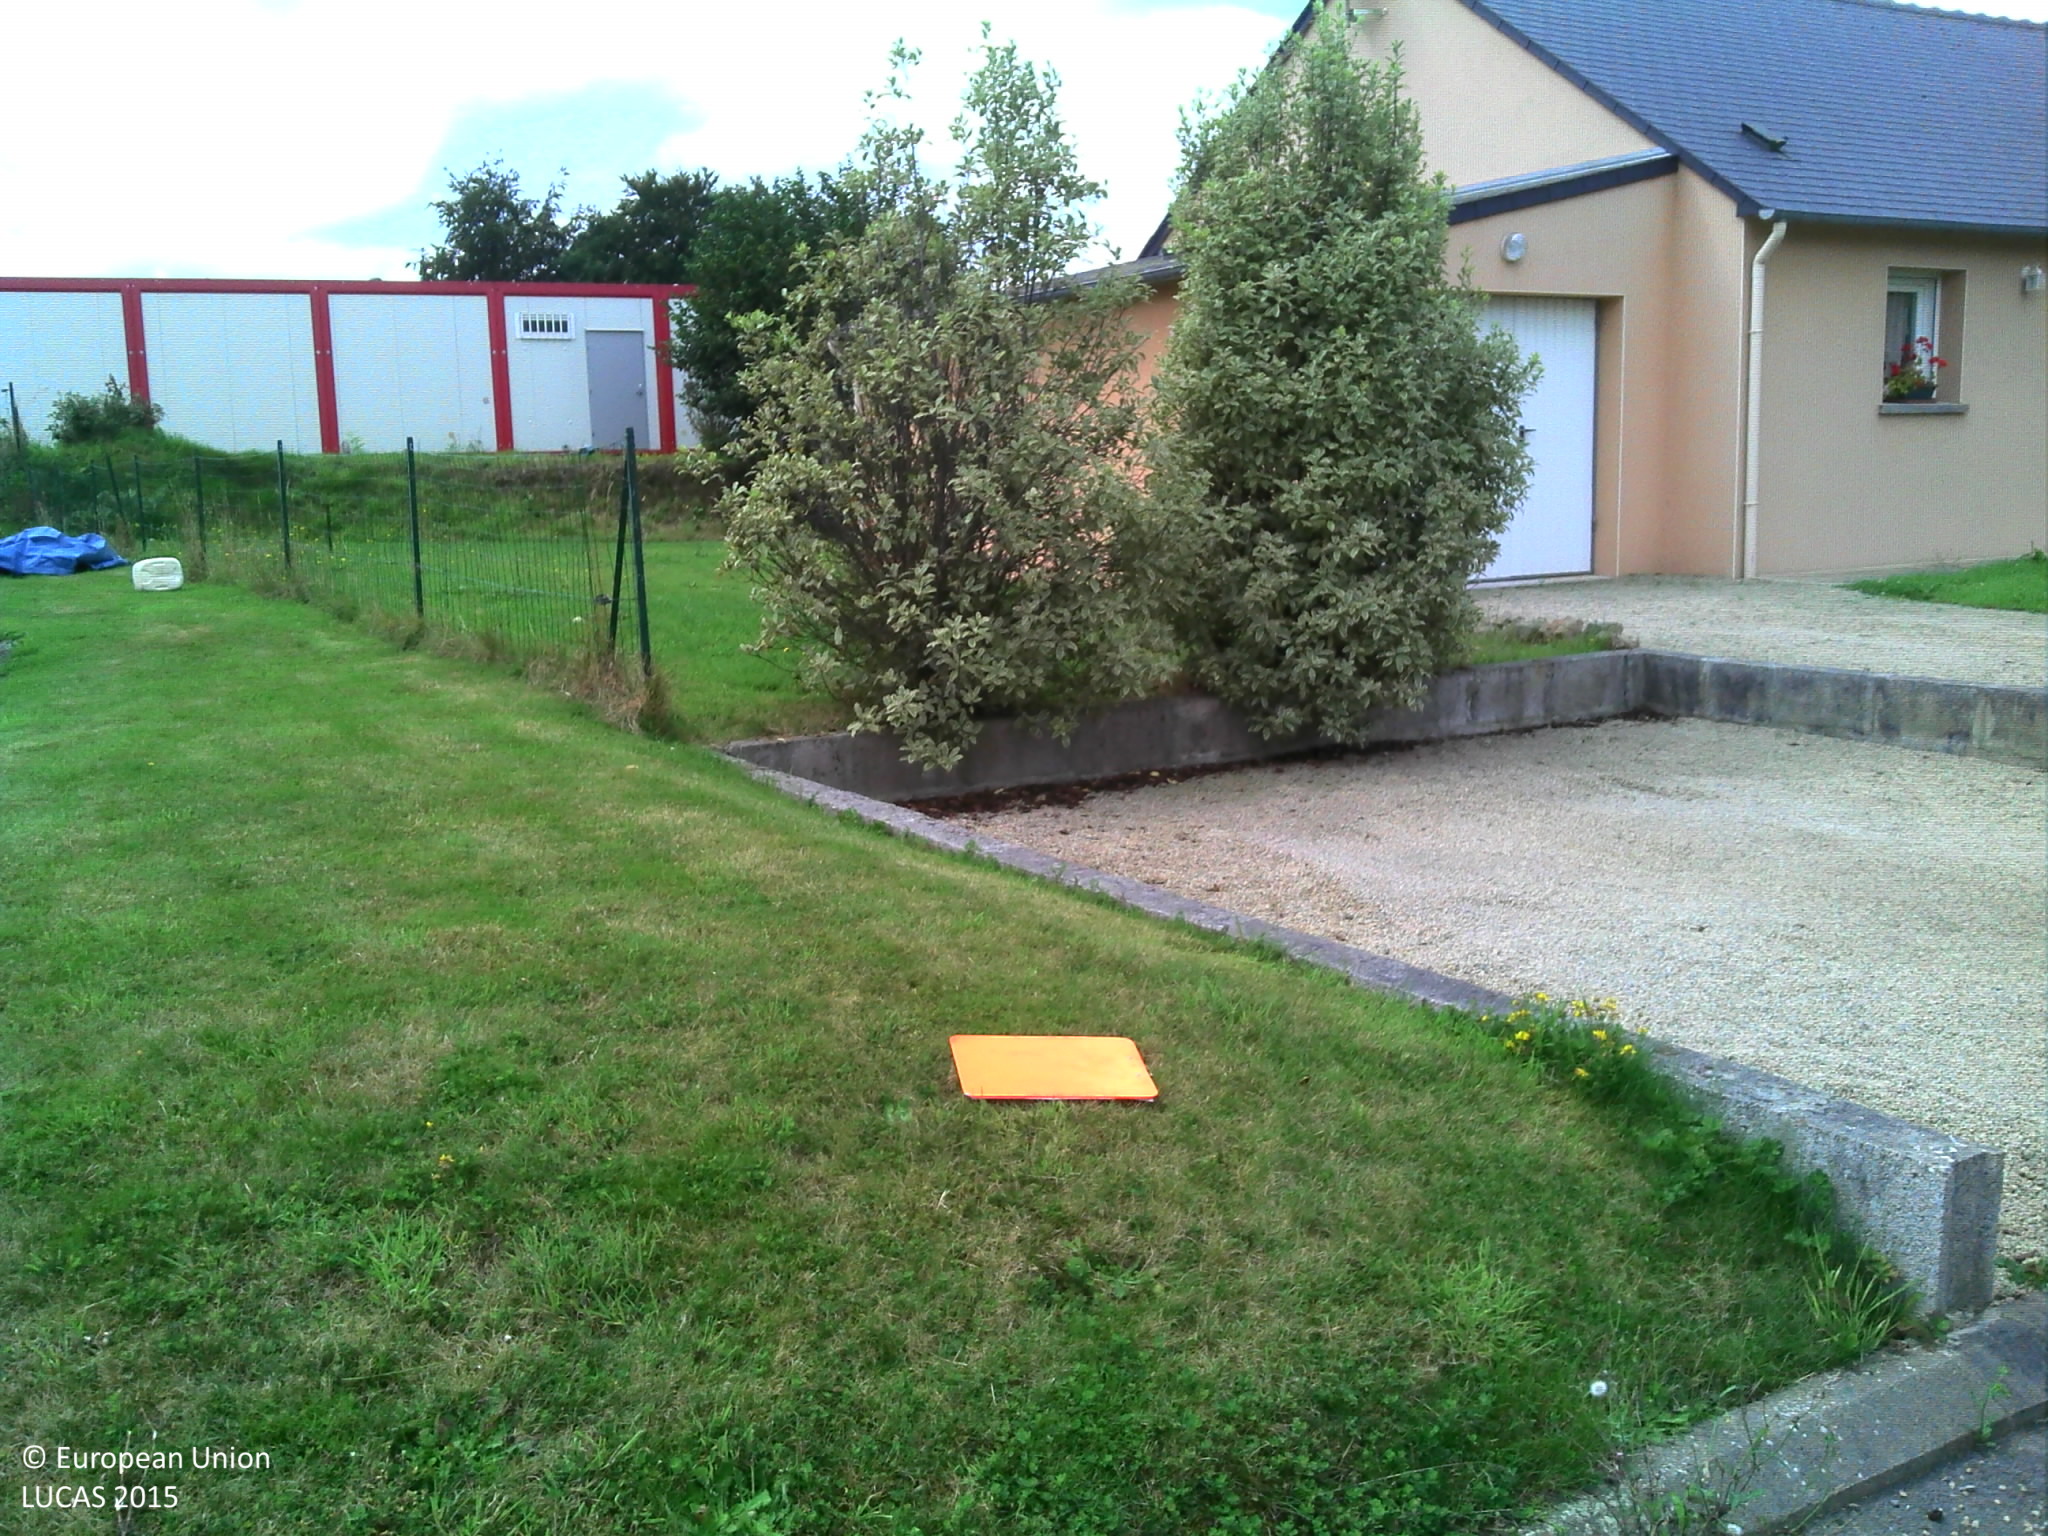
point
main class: Grassland
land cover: Grassland without tree/shrub cover
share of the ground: > 75 %
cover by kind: herbaceous plants 100 %
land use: Residential
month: August
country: FR
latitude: 48.6149
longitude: -3.1629
